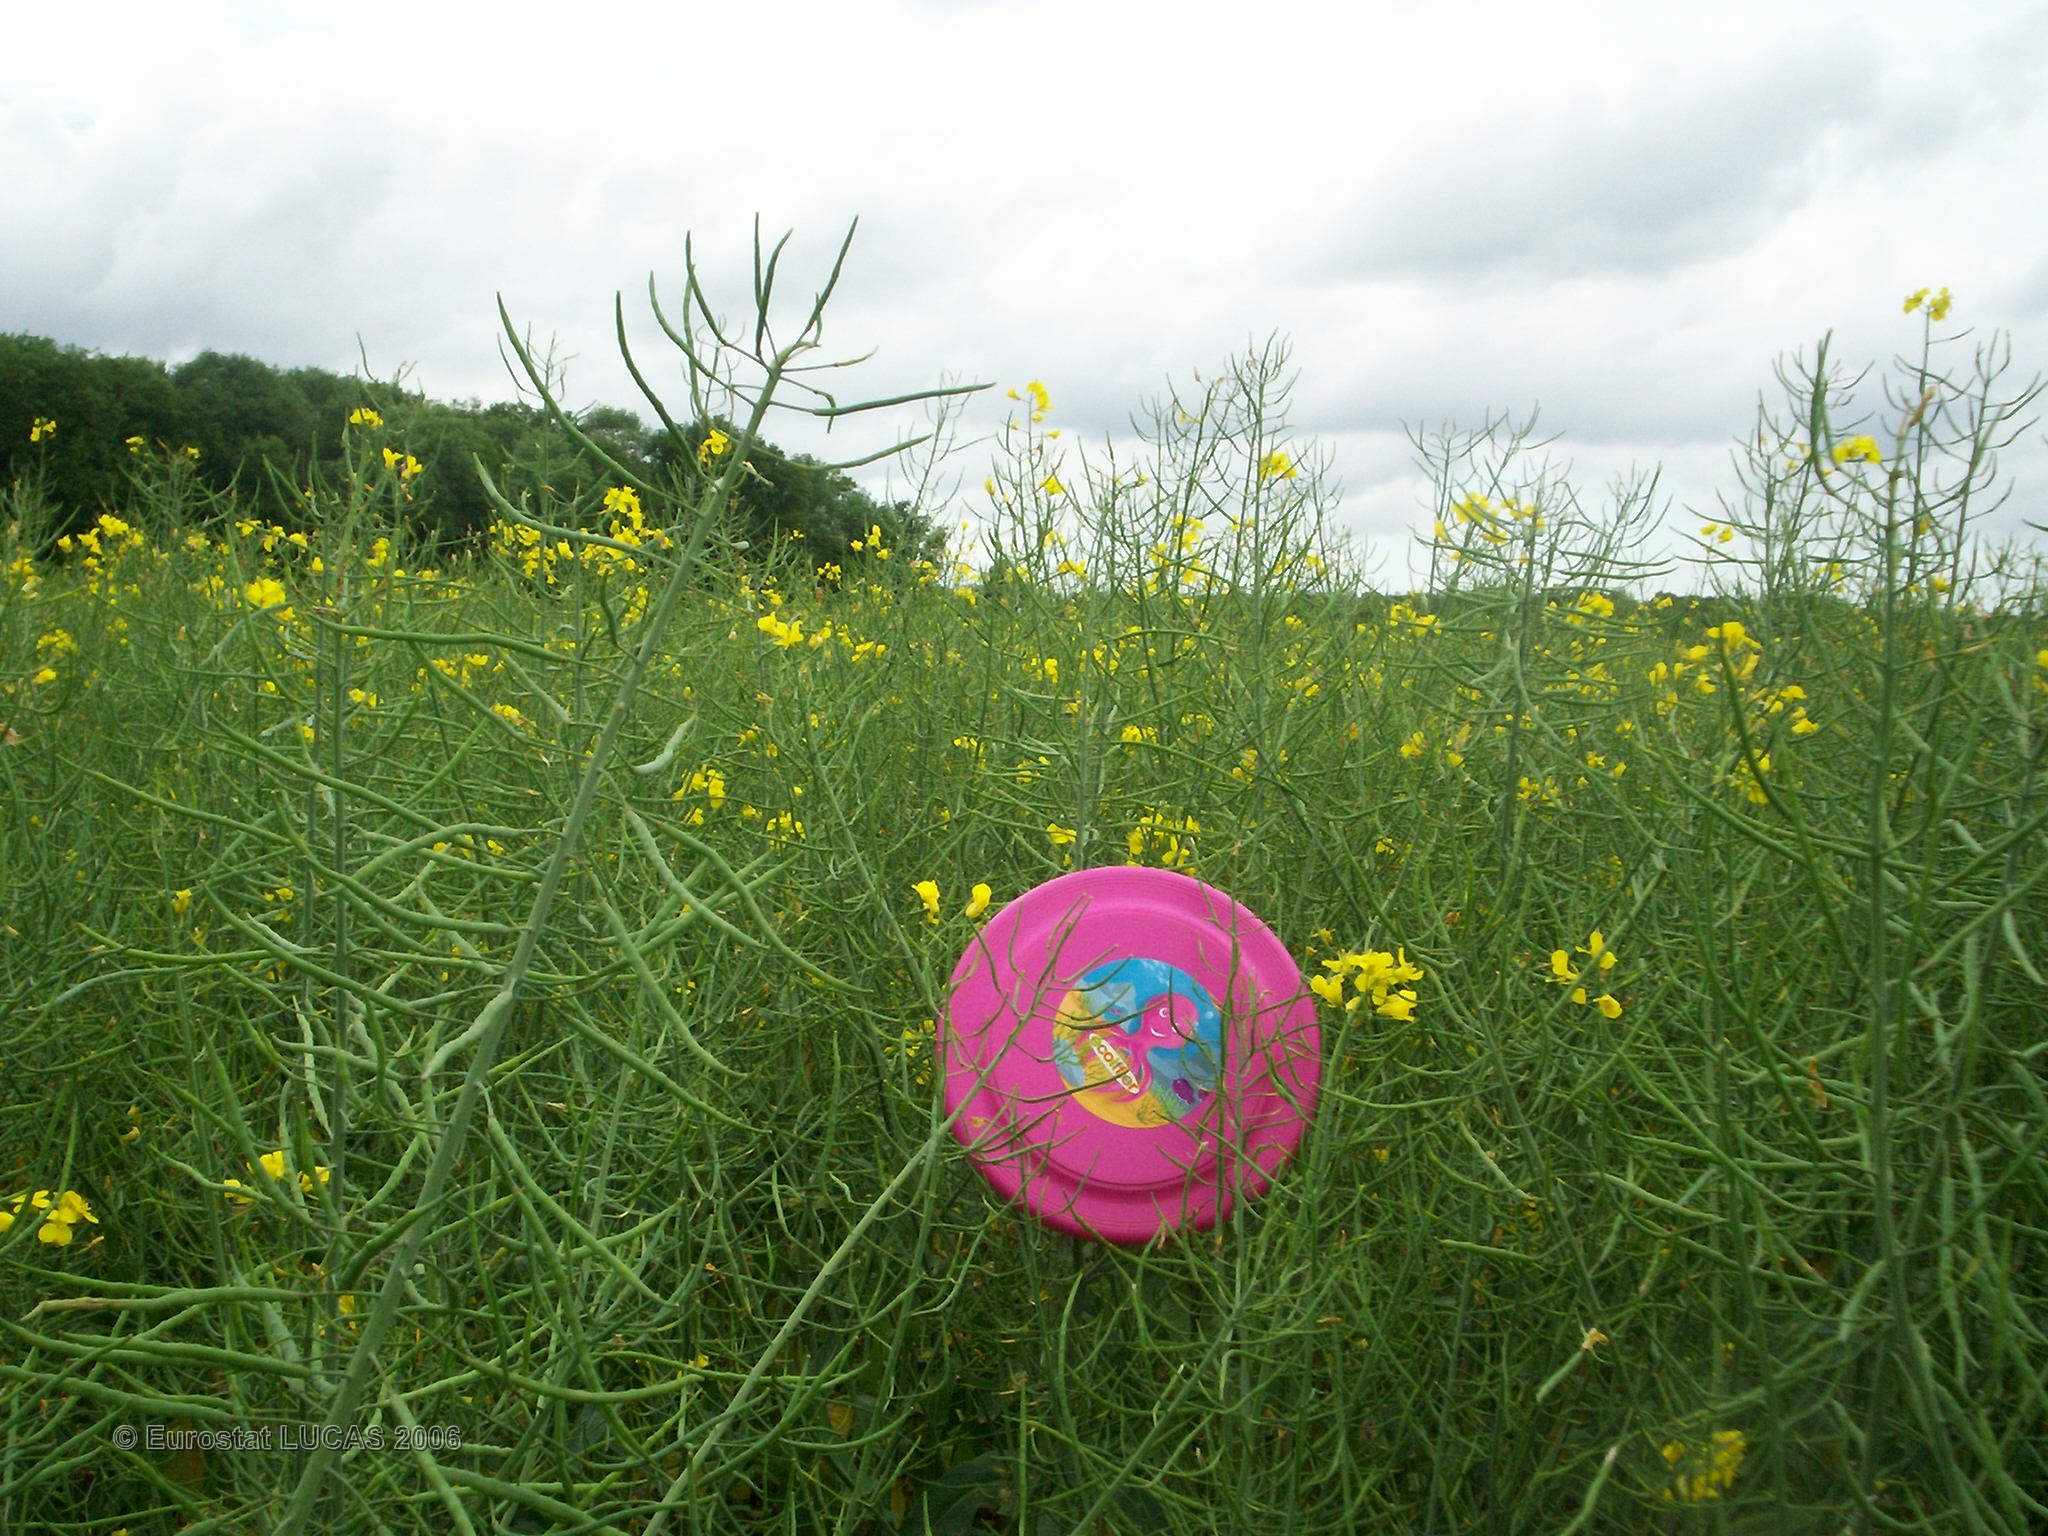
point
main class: Cropland
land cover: Rape and turnip rape
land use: Agriculture (excluding fallow land and kitchen gardens)
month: May
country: FR
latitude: 47.7995
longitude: 2.9572
